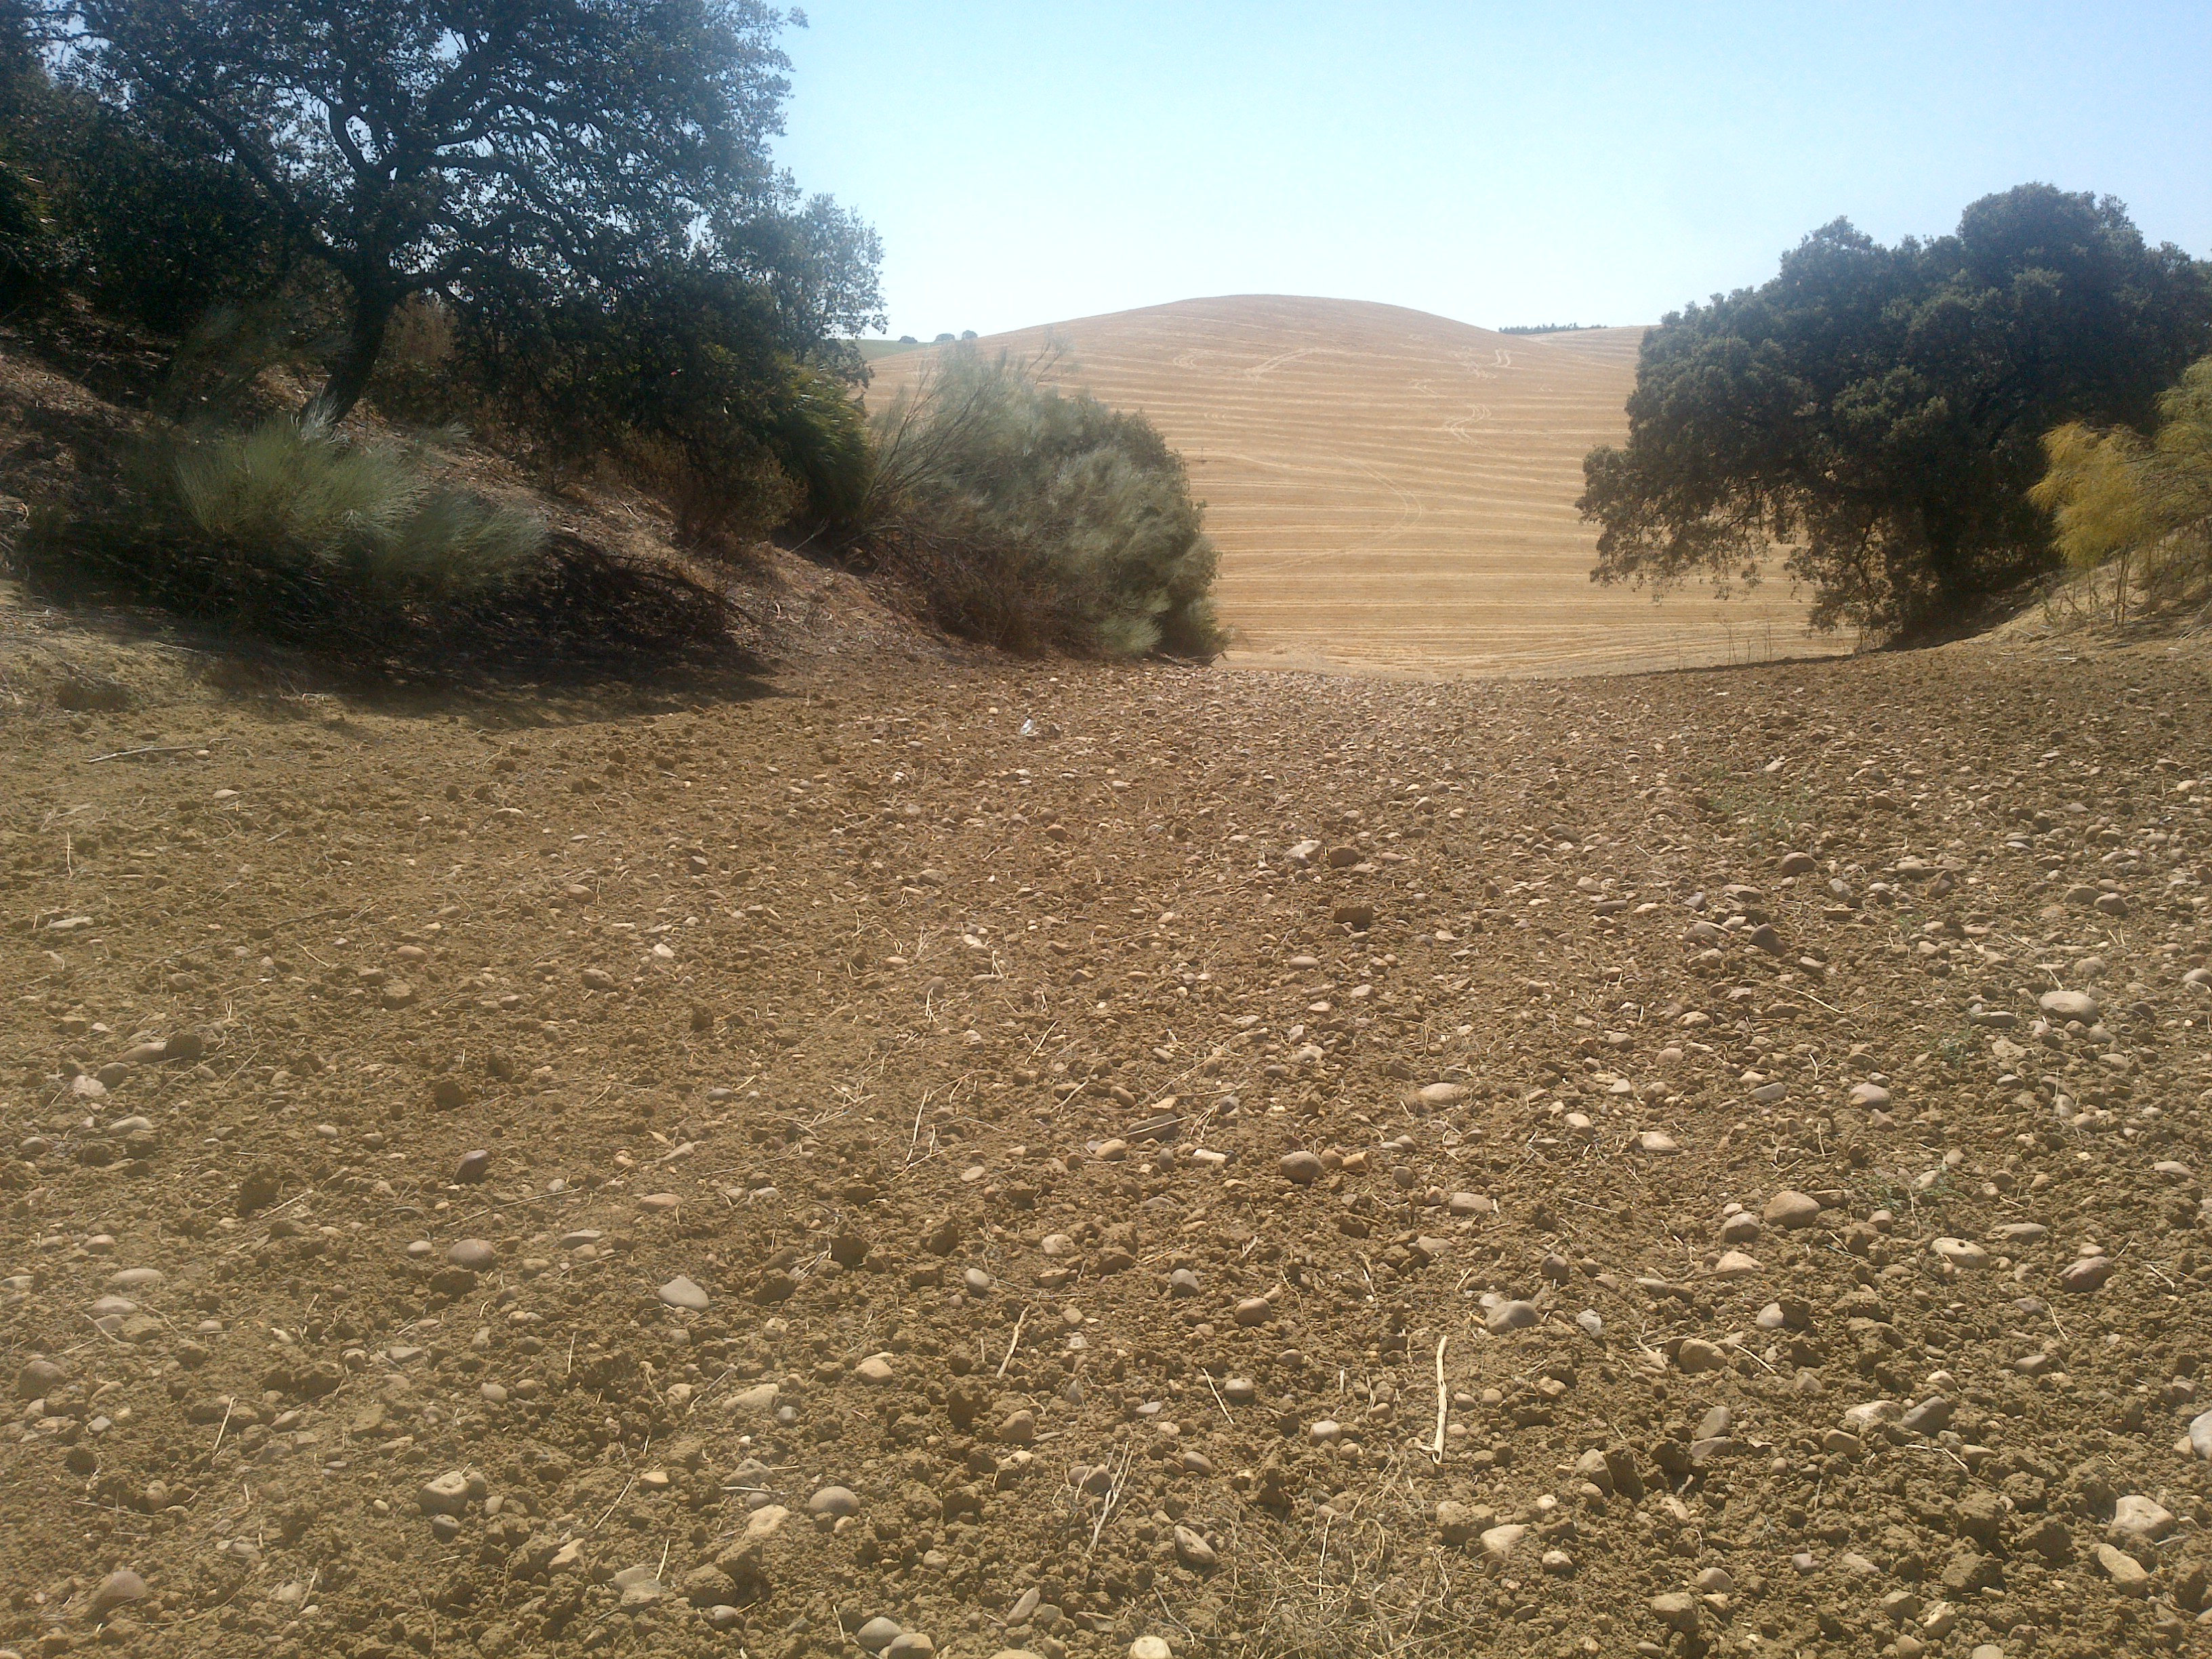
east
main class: Woodland
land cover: Broadleaved woodland
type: broadleaved evergreen forest
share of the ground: 25 - 50 %
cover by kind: shrubs 50 %, broadleaved forest trees 25 %, unconsolidated bare surface 15 %, herbaceous plants 10 %
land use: Semi-natural and natural areas not in use
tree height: < 5 m
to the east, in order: Broadleaved woodland; Other bare soil
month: June
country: ES
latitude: 37.7241
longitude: -4.9101
